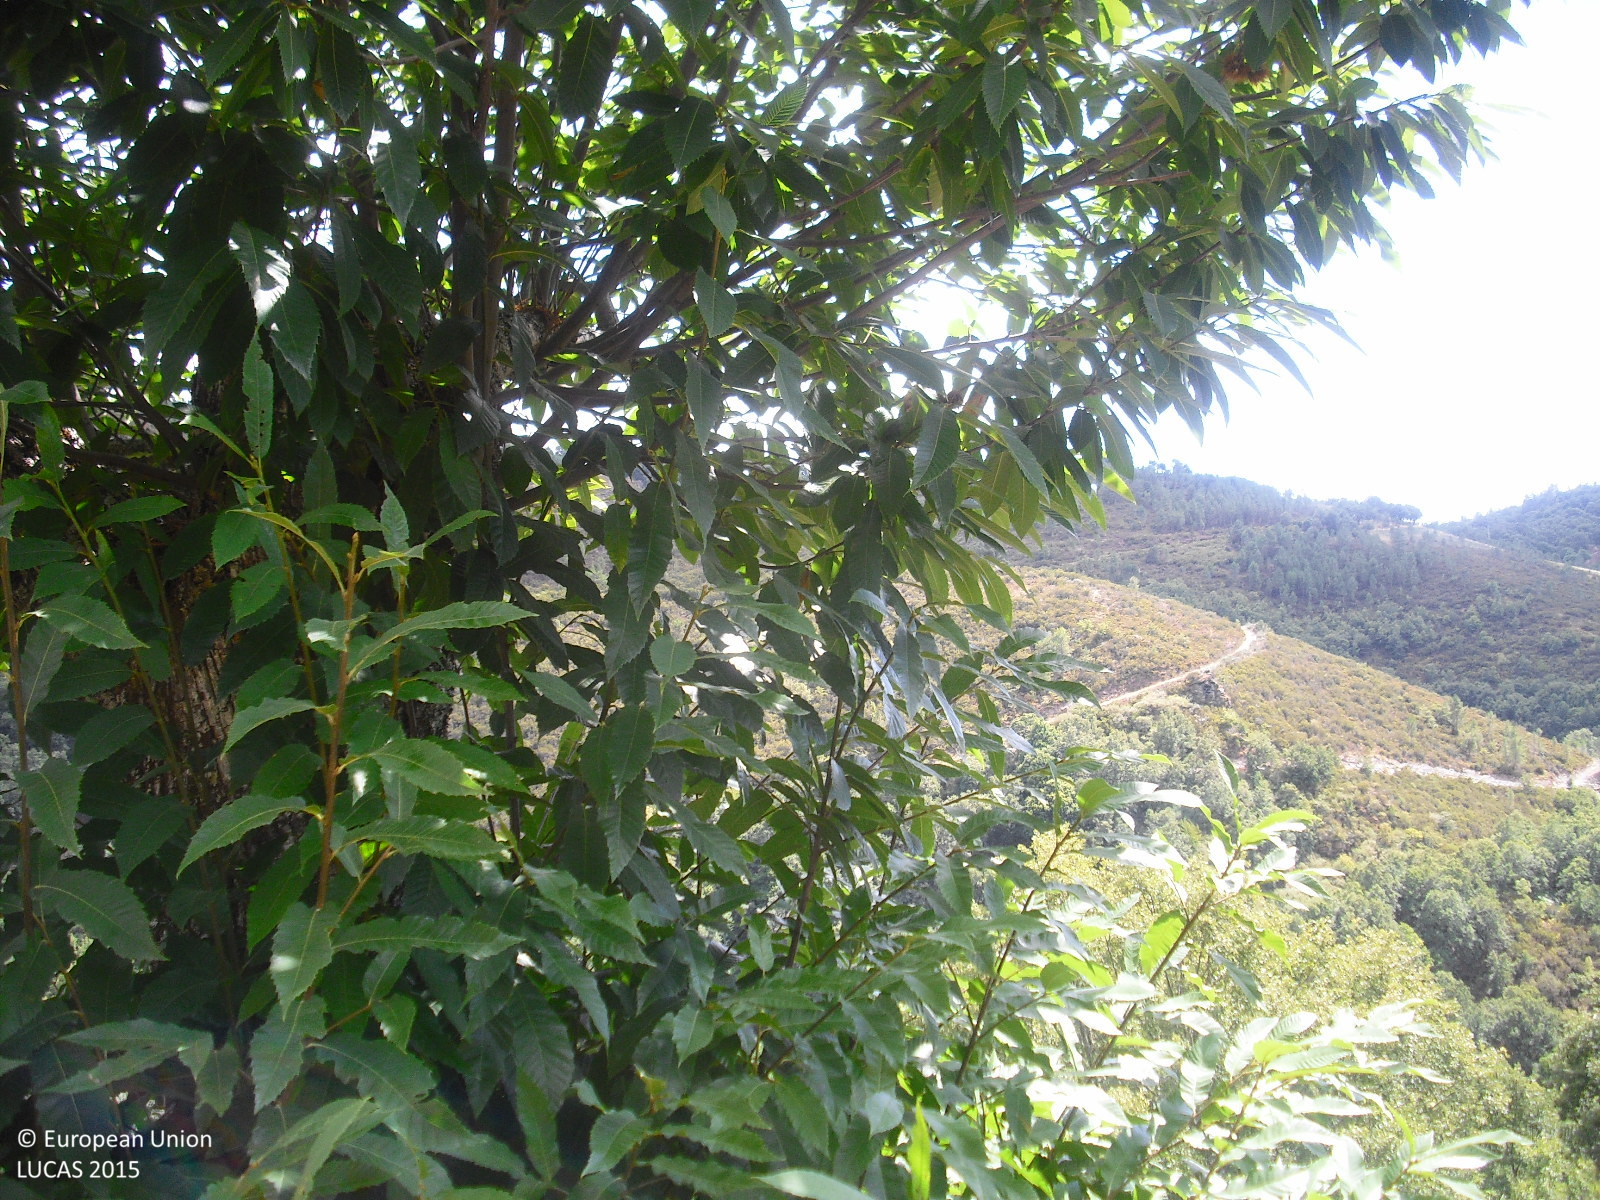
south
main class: Shrubland
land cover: Shrubland without tree cover
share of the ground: > 75 %
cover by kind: shrubs 100 %
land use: Semi-natural and natural areas not in use
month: August
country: ES
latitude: 42.0734
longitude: -7.4053
